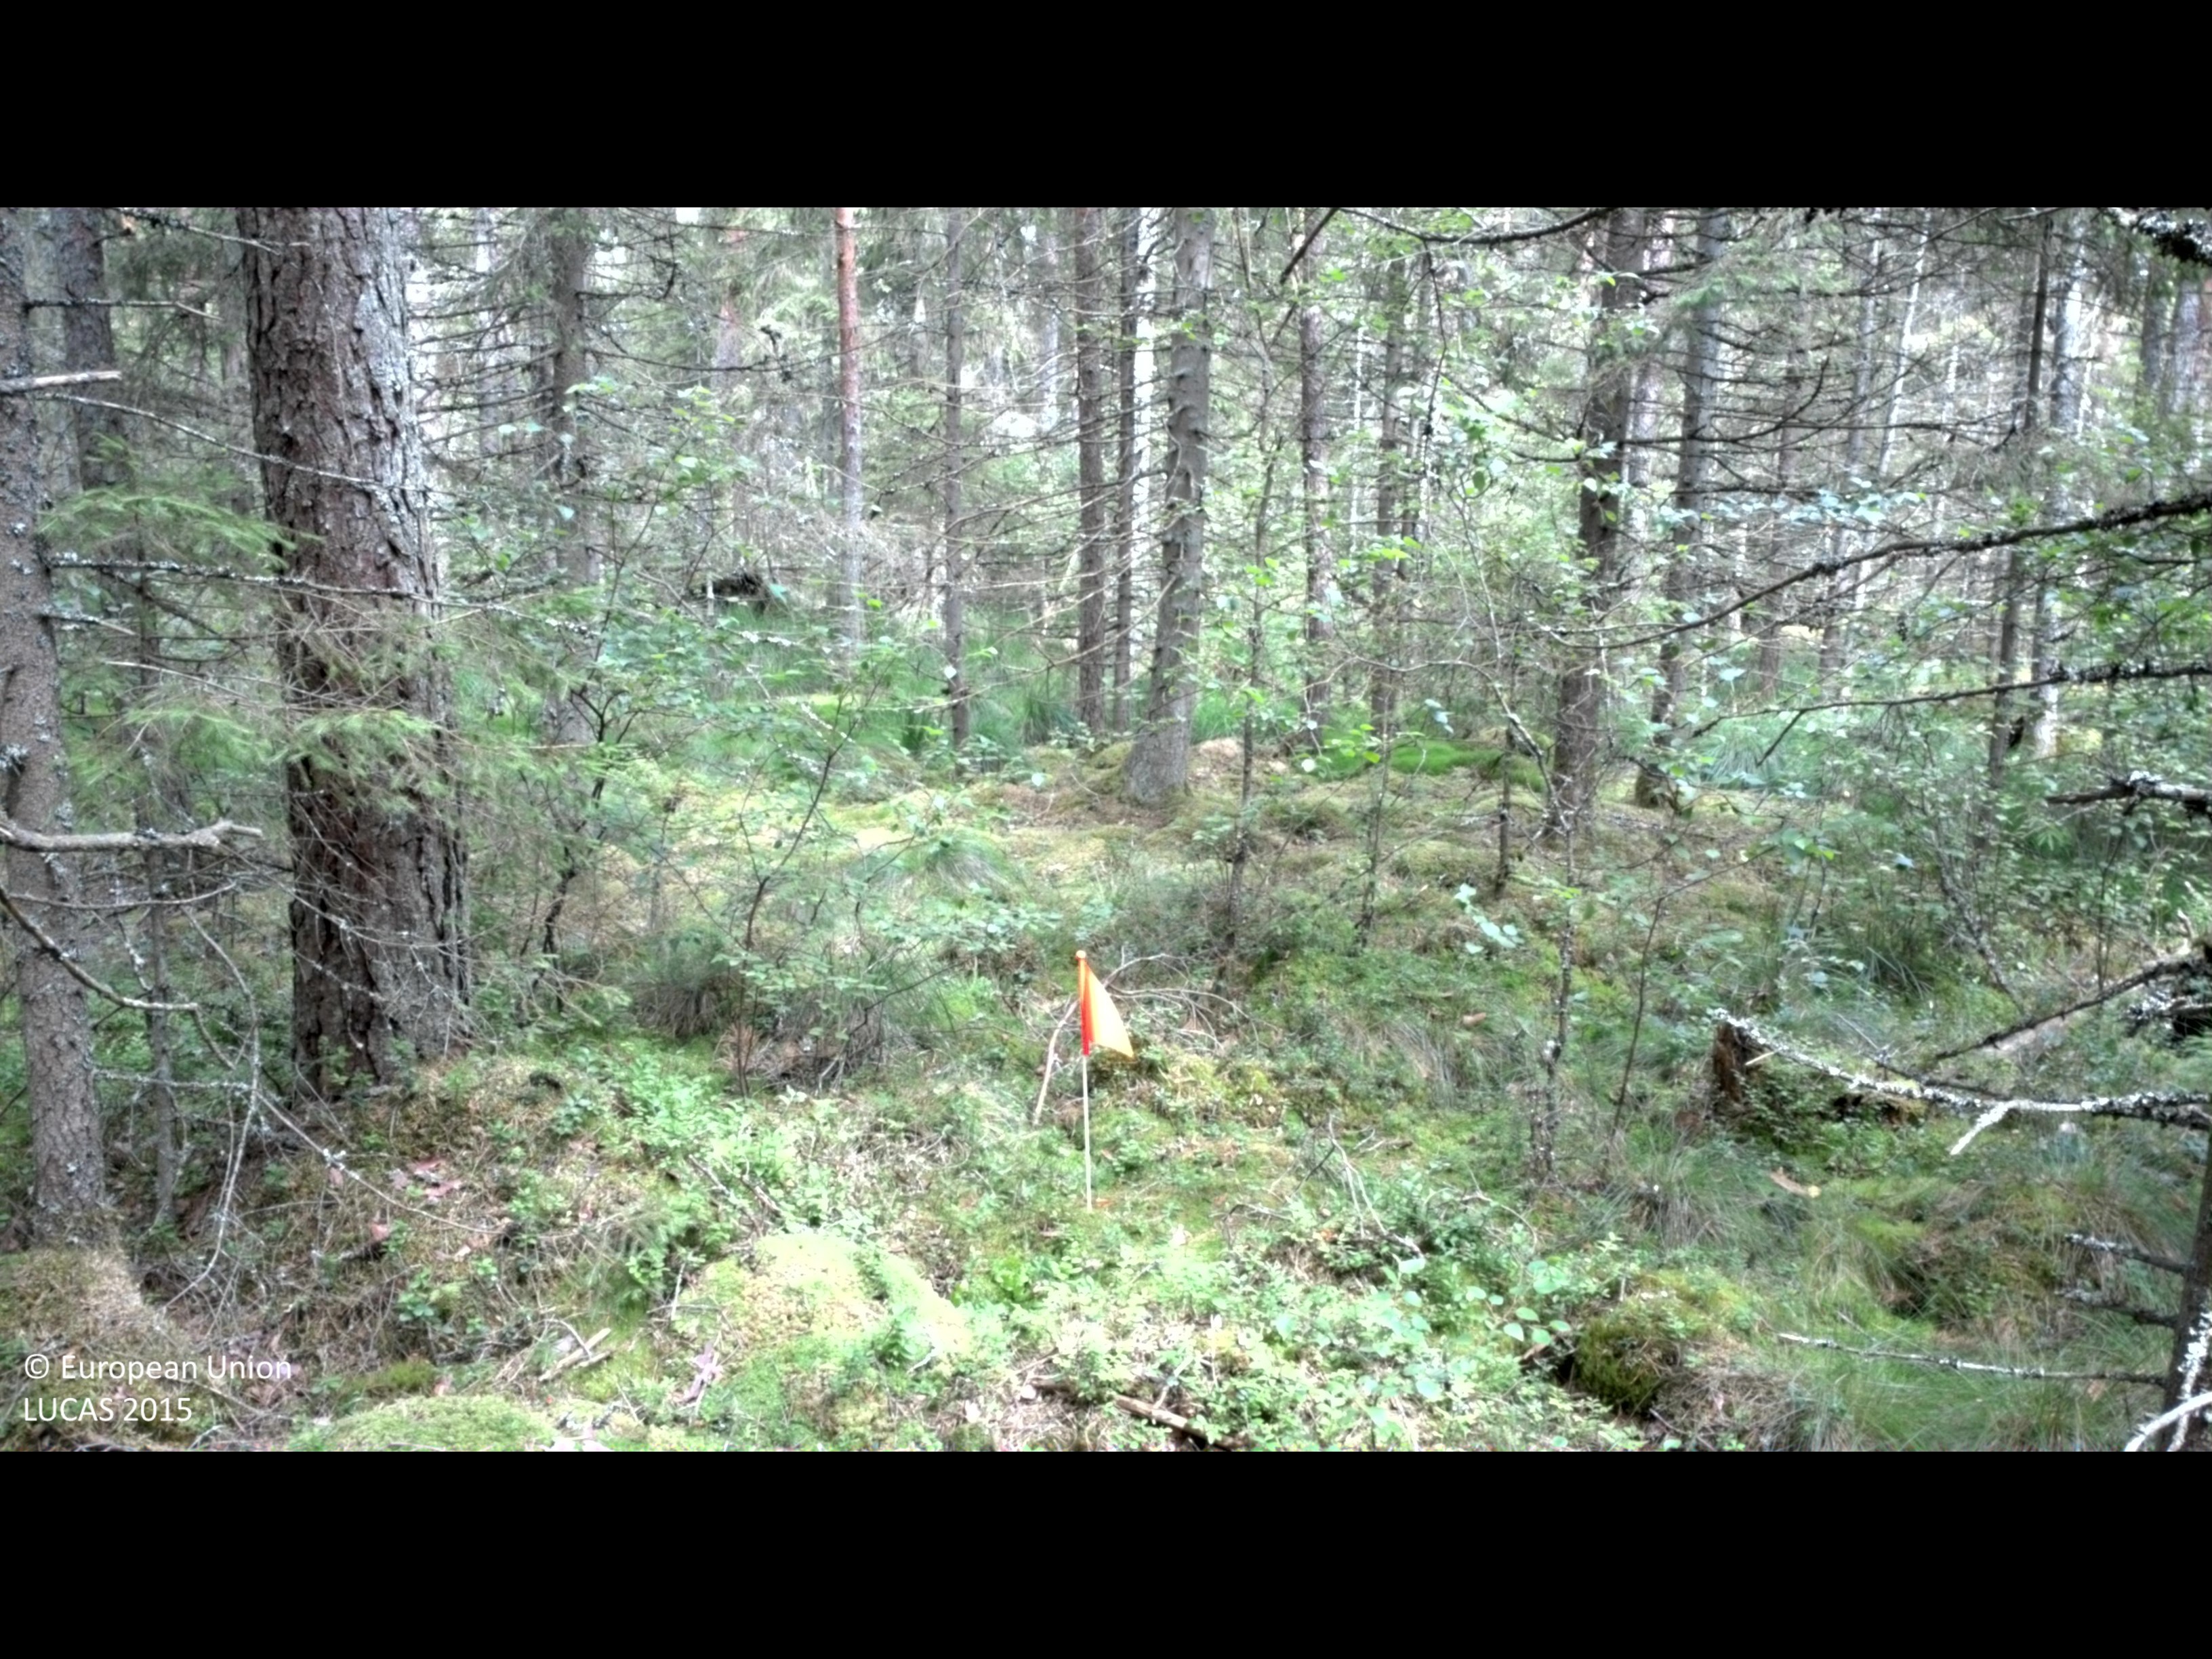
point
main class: Woodland
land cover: Spruce dominated coniferous woodland
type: boreal forest
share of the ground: > 75 %
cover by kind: coniferous forest trees 80 %, herbaceous plants 10 %, broadleaved forest trees 5 %, shrubs 5 %
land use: Forestry
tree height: > 5 m
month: August
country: SE
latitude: 56.7443
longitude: 13.7737
